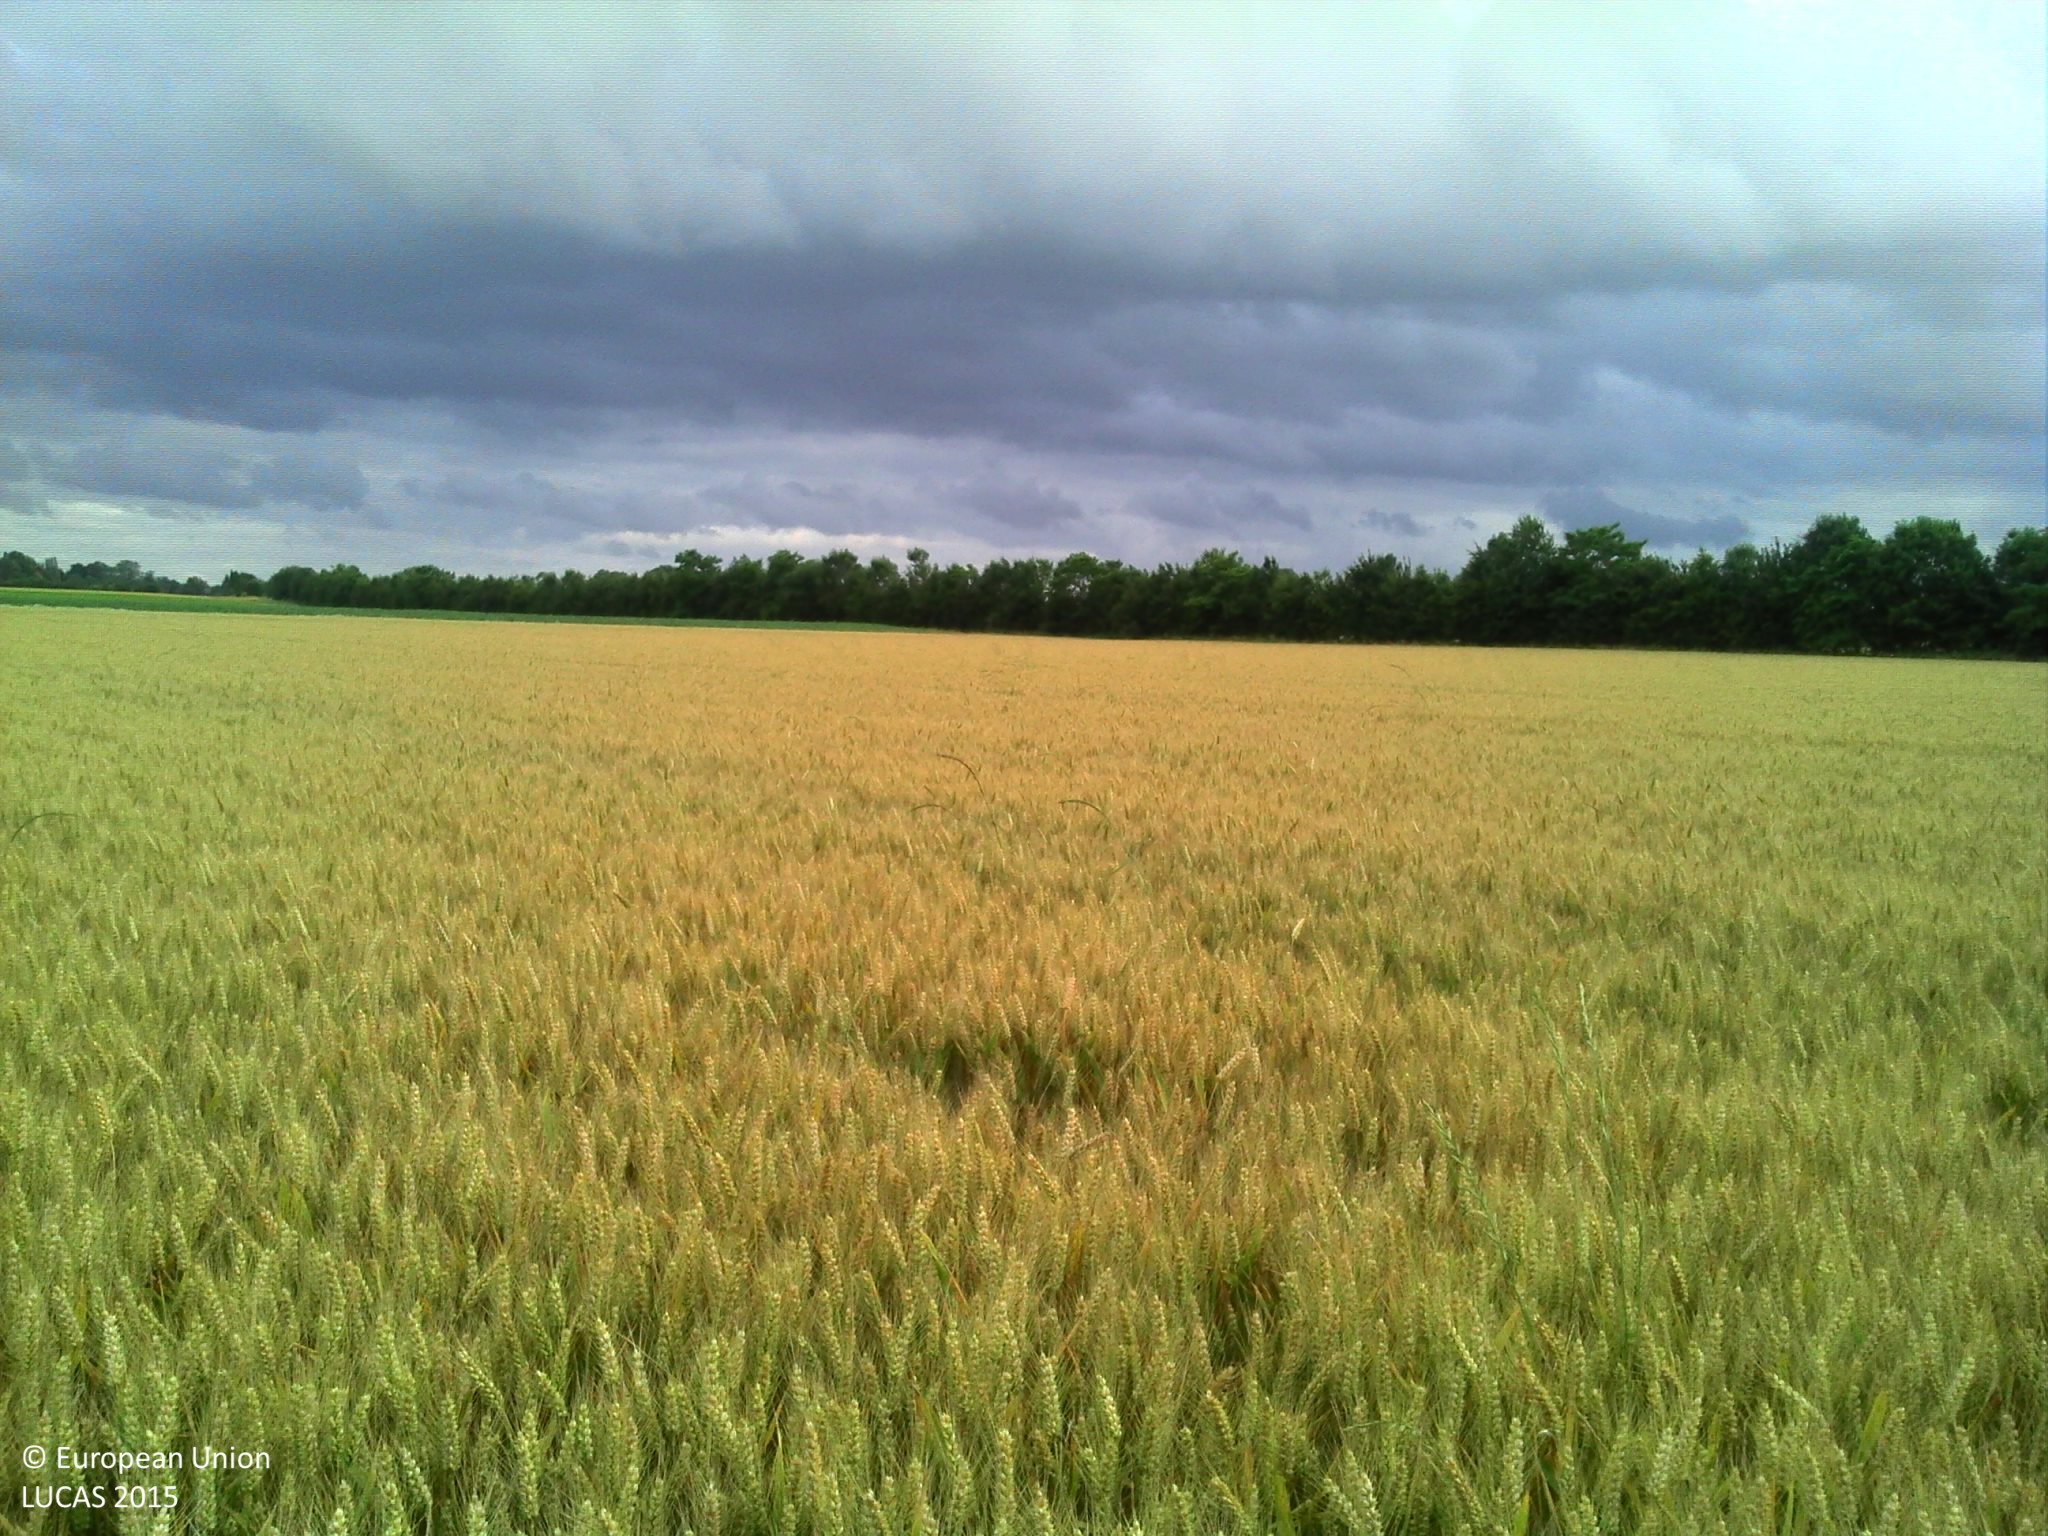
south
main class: Cropland
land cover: Common wheat
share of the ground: > 75 %
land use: Agriculture (excluding fallow land and kitchen gardens)
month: July
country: FR
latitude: 49.1815
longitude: 0.4109
